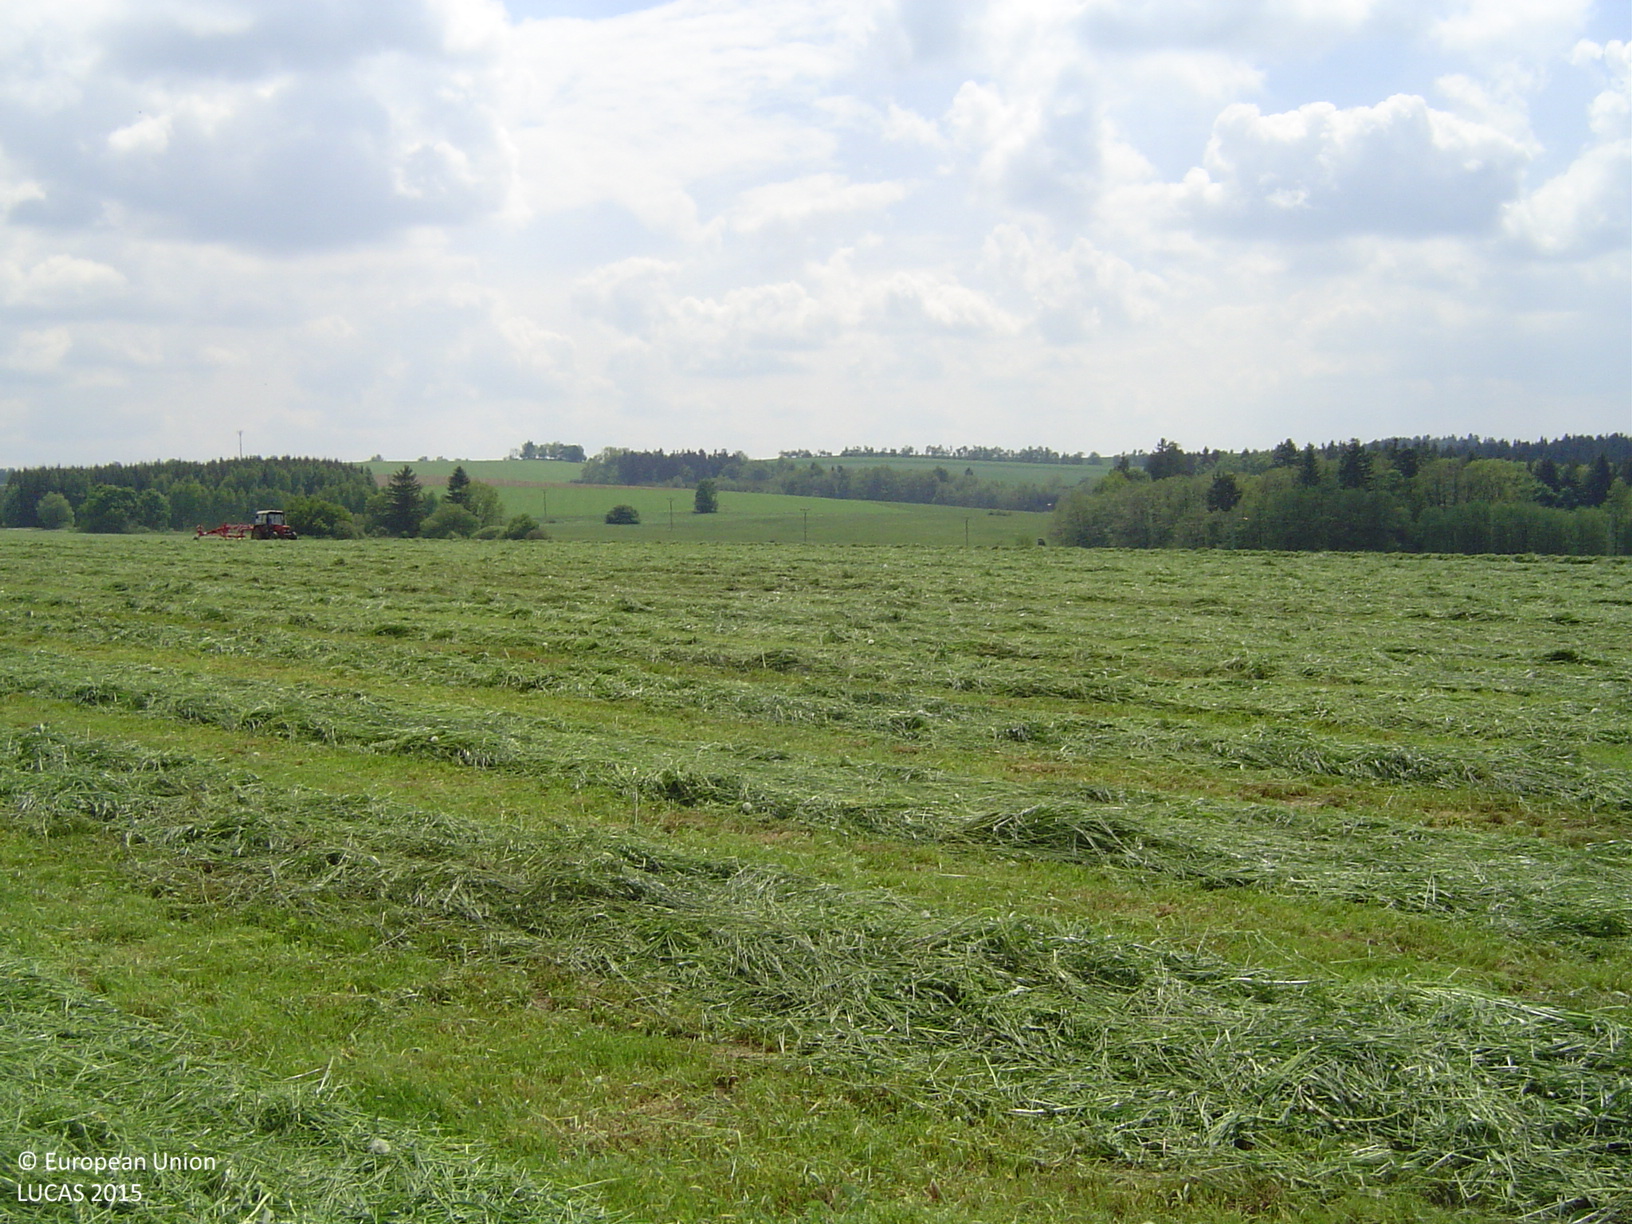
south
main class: Grassland
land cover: Grassland without tree/shrub cover
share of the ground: > 75 %
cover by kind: herbaceous plants 100 %
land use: Agriculture (excluding fallow land and kitchen gardens)
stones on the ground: < 10 %
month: May
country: CZ
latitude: 49.6488
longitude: 16.3084
